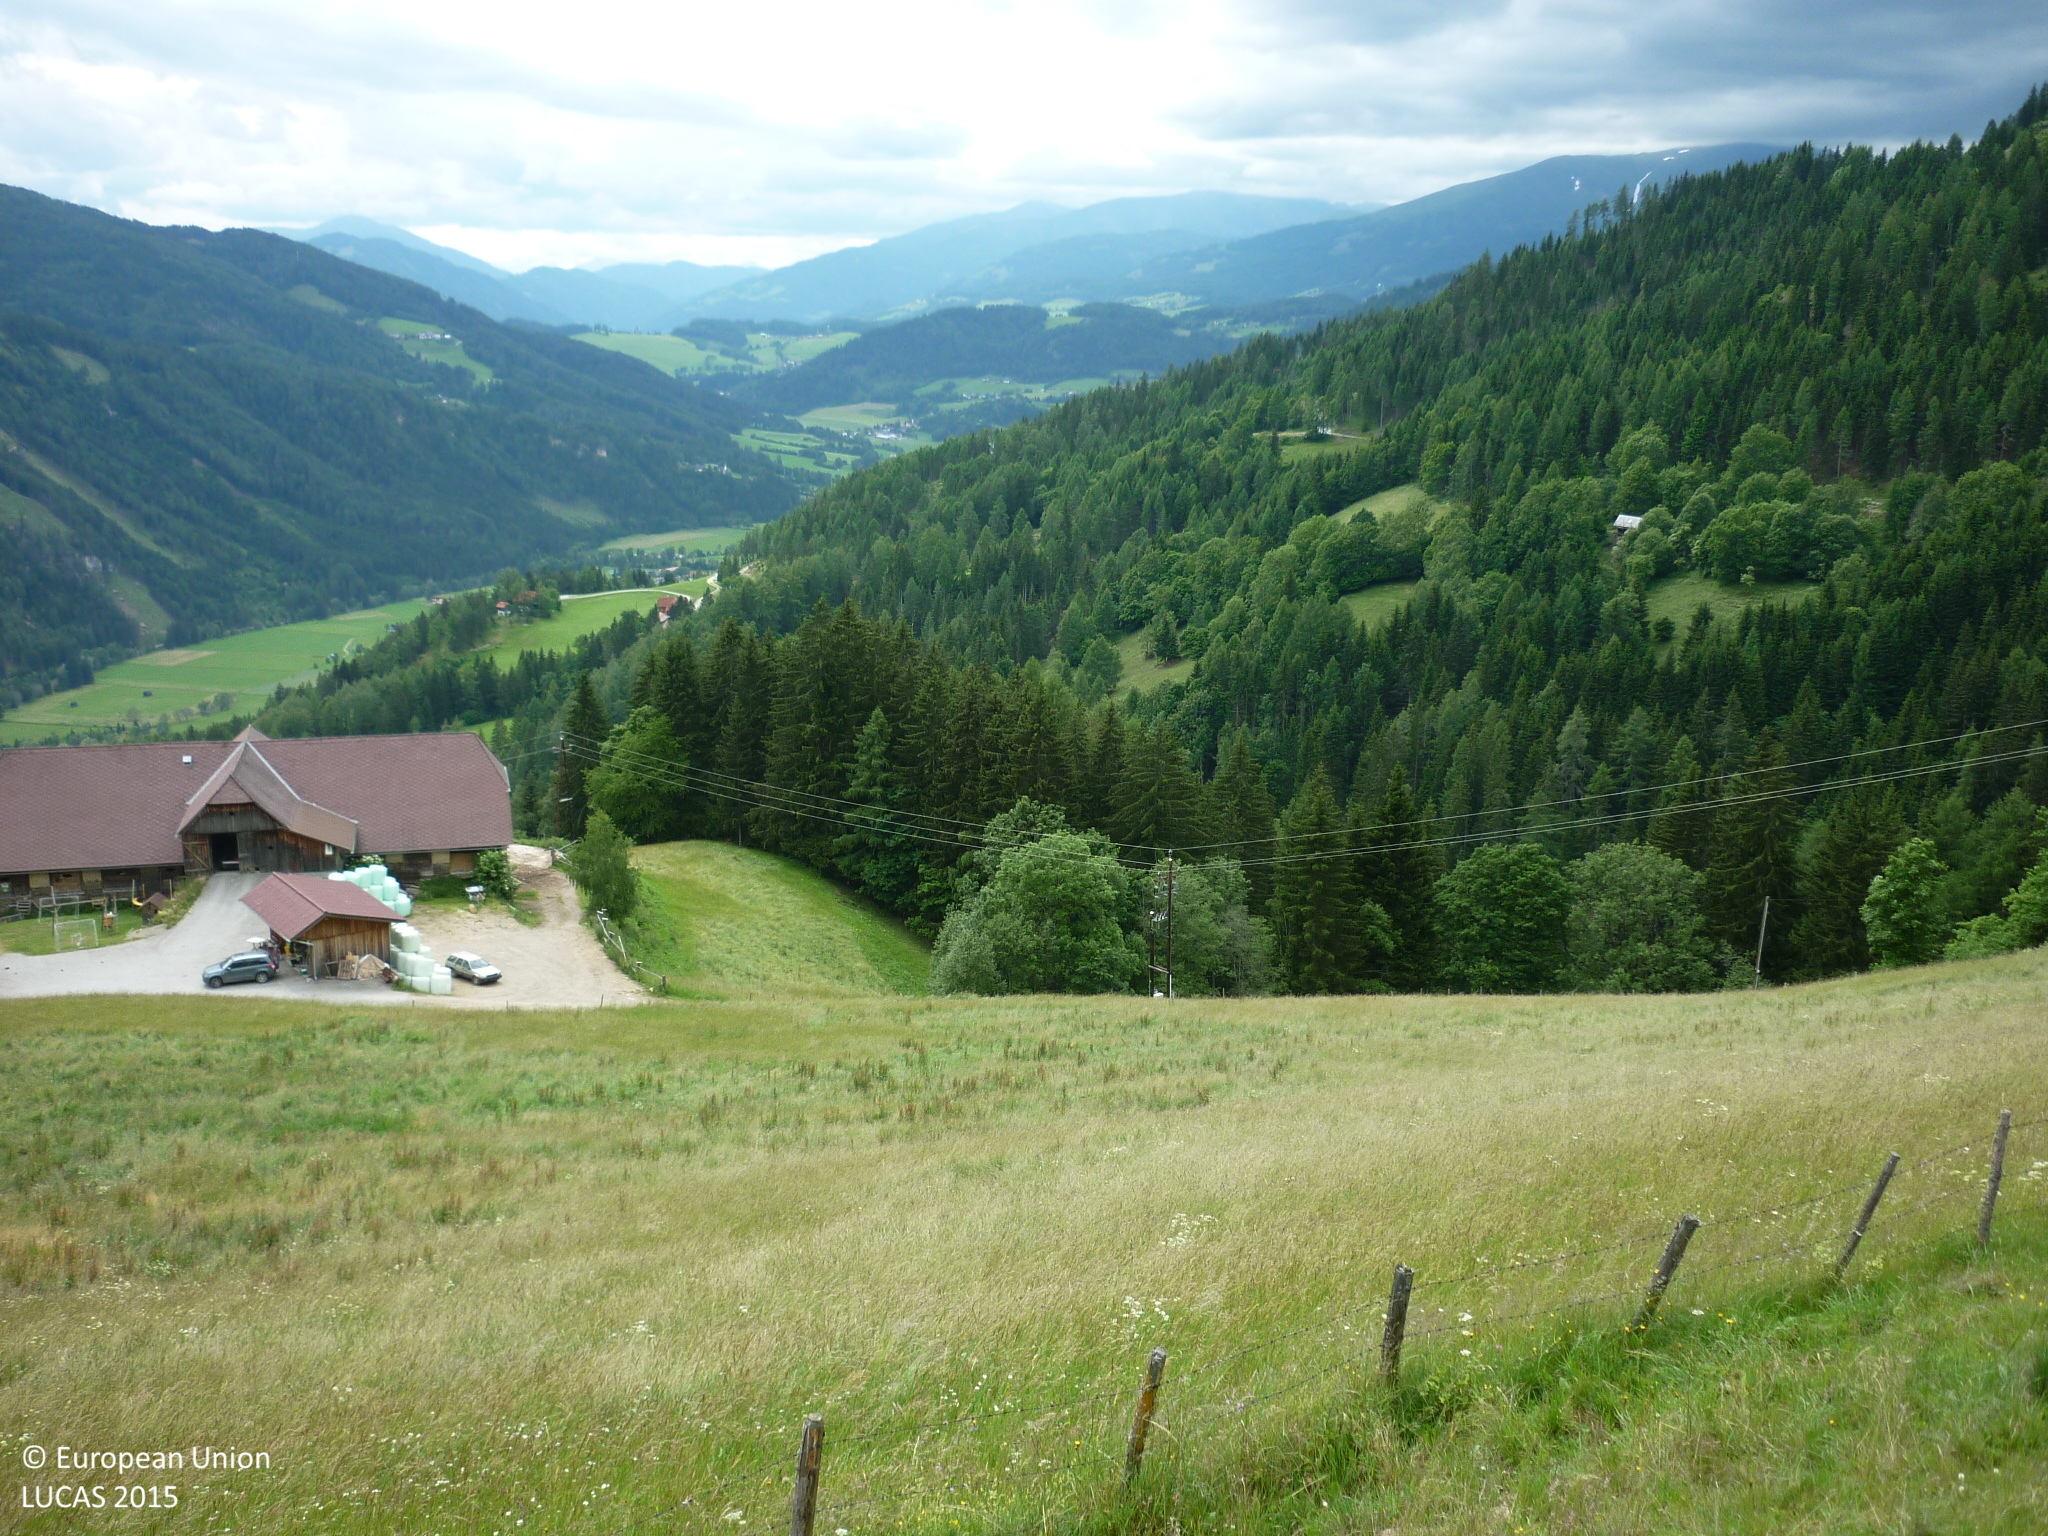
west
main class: Grassland
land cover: Grassland with sparse tree/shrub cover
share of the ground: > 75 %
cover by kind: herbaceous plants 85 %, broadleaved forest trees 5 %, shrubs 5 %, consolidated bare surface 5 %
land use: Agriculture (excluding fallow land and kitchen gardens)
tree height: < 5 m
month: June
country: AT
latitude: 47.2019
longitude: 14.3151
